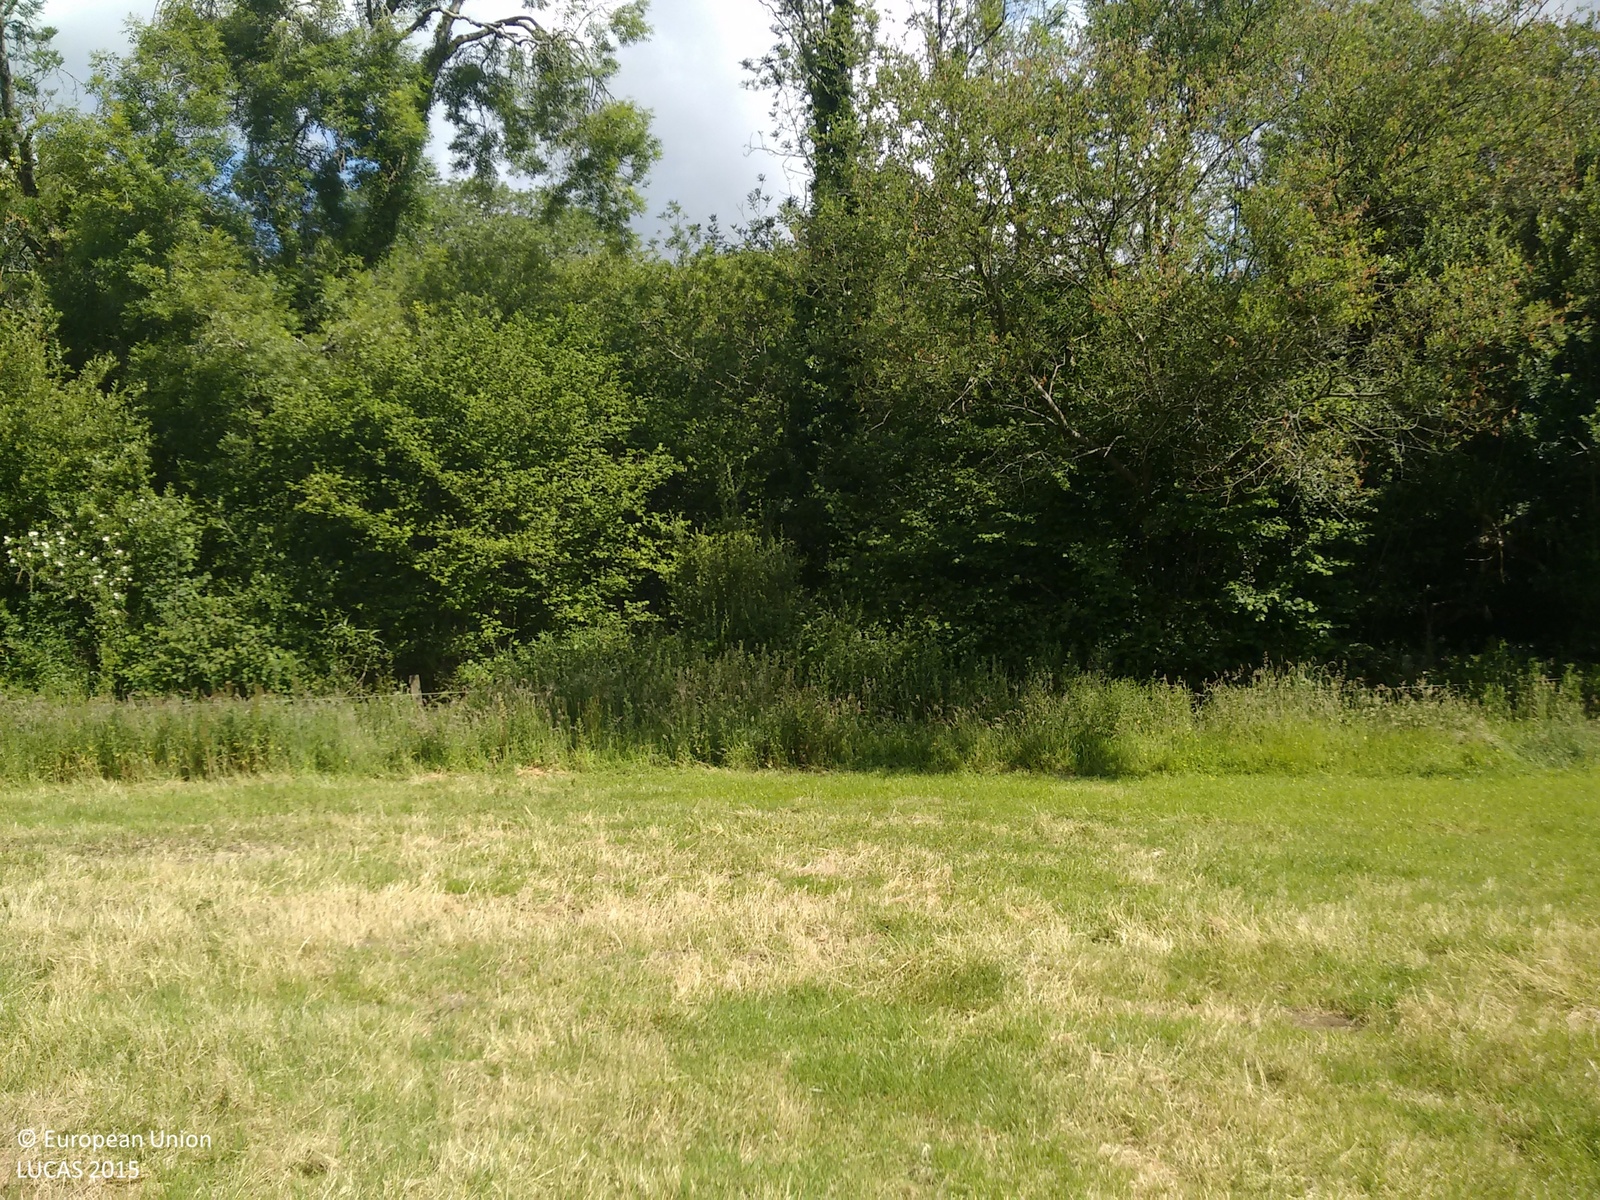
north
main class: Grassland
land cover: Grassland without tree/shrub cover
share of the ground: > 75 %
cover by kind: herbaceous plants 100 %
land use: Agriculture (excluding fallow land and kitchen gardens)
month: June
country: GB
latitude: 50.7501
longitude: -2.1505
